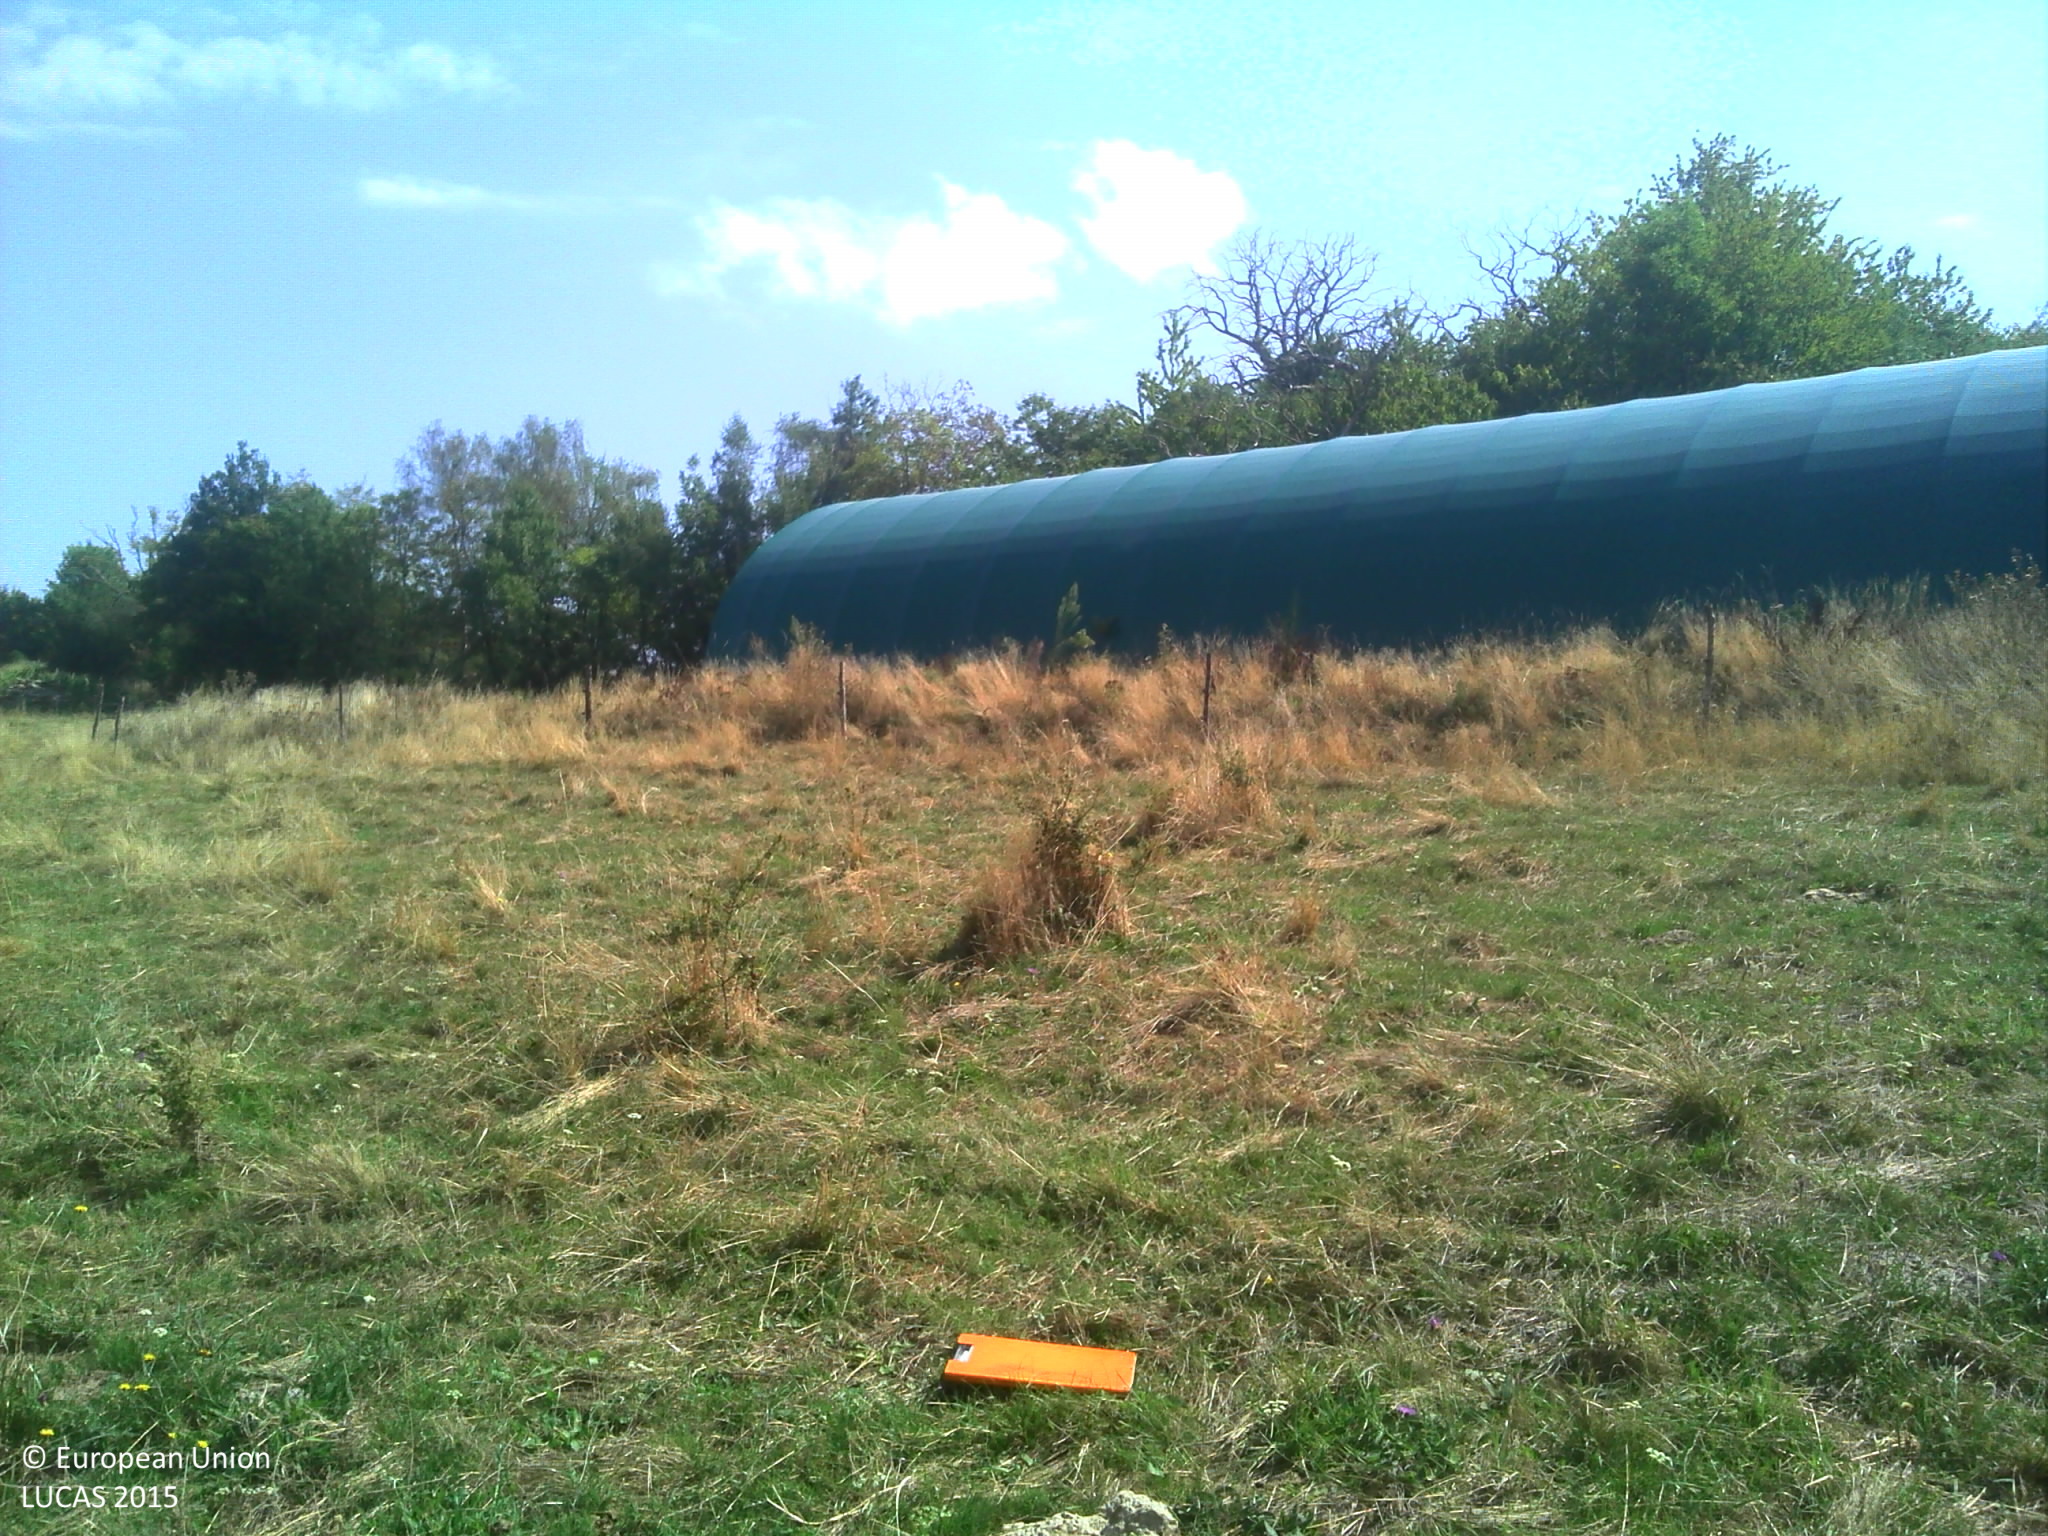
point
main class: Grassland
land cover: Grassland without tree/shrub cover
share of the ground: > 75 %
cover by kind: herbaceous plants 95 %, shrubs 5 %
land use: Agriculture (excluding fallow land and kitchen gardens)
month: September
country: FR
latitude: 45.1946
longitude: 5.1554
